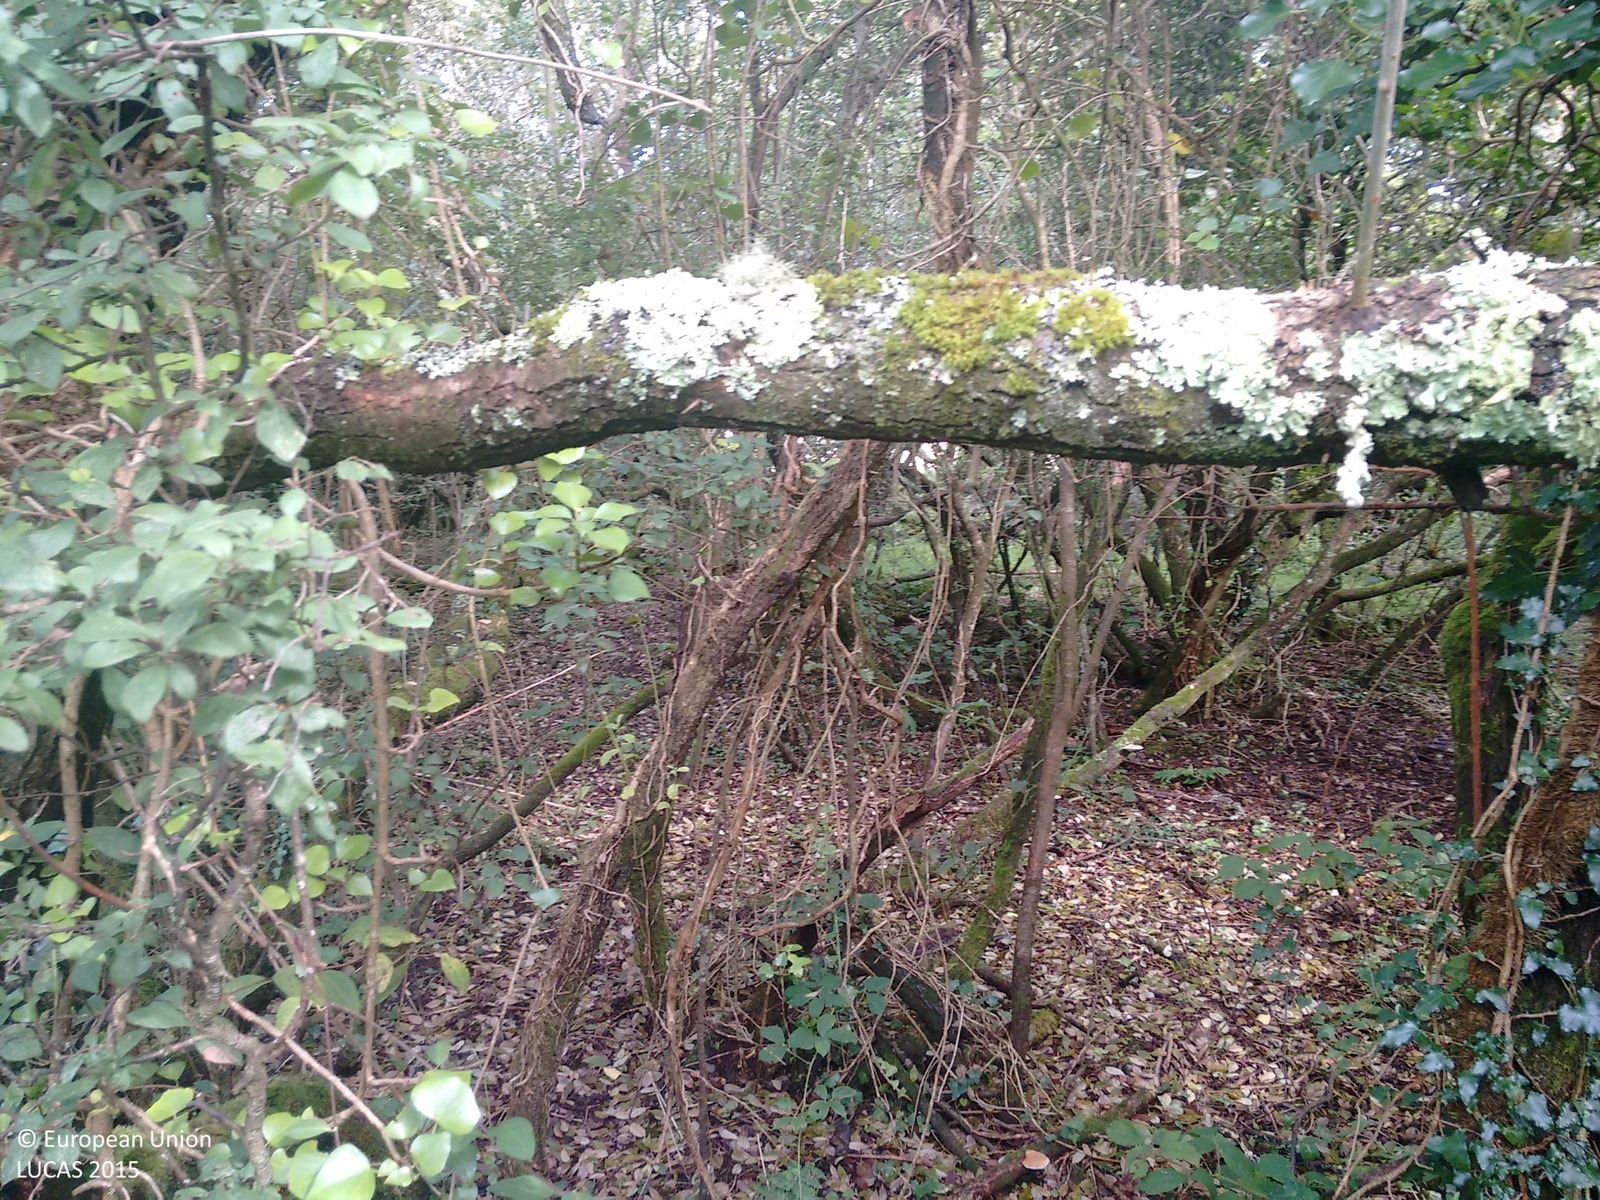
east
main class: Woodland
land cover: Broadleaved woodland
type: mesophytic deciduous forest
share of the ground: > 75 %
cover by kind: broadleaved forest trees 100 %
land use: Forestry
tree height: > 5 m
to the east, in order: Broadleaved woodland; Grassland without tree/shrub cover; Shrubland with sparse tree cover; Grassland without tree/shrub cover; Shrubland with sparse tree cover
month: August
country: GB
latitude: 49.9990
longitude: -5.2007
